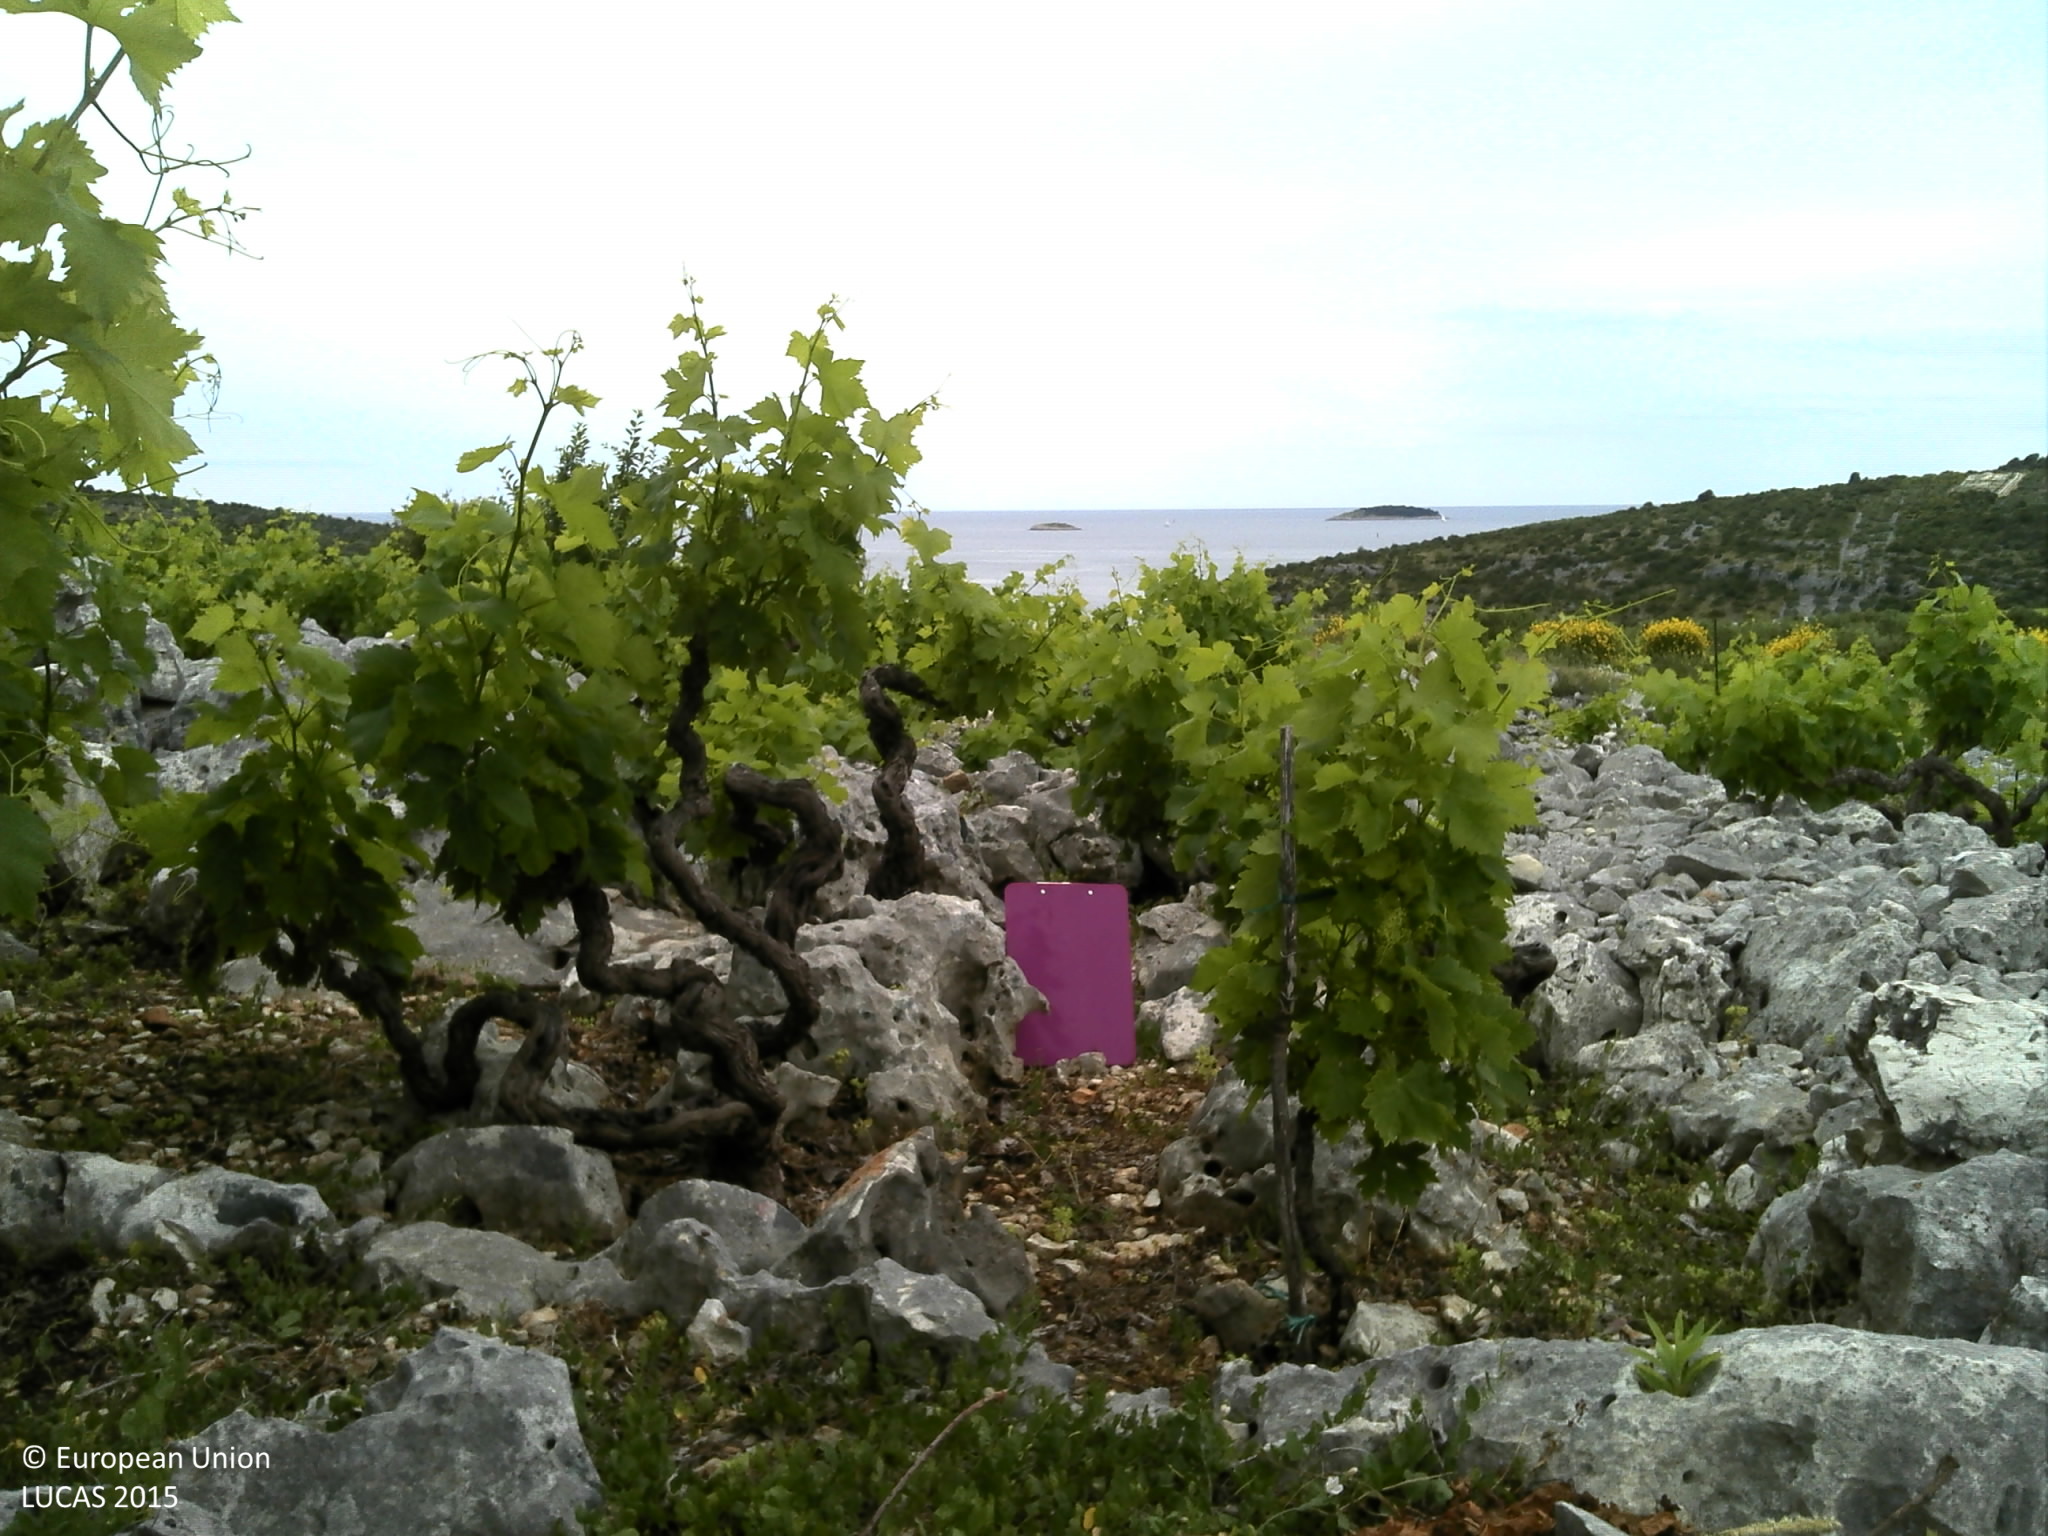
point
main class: Cropland
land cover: Vineyards
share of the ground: 25 - 50 %
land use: Agriculture (excluding fallow land and kitchen gardens)
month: May
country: HR
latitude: 43.5652
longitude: 15.9456
